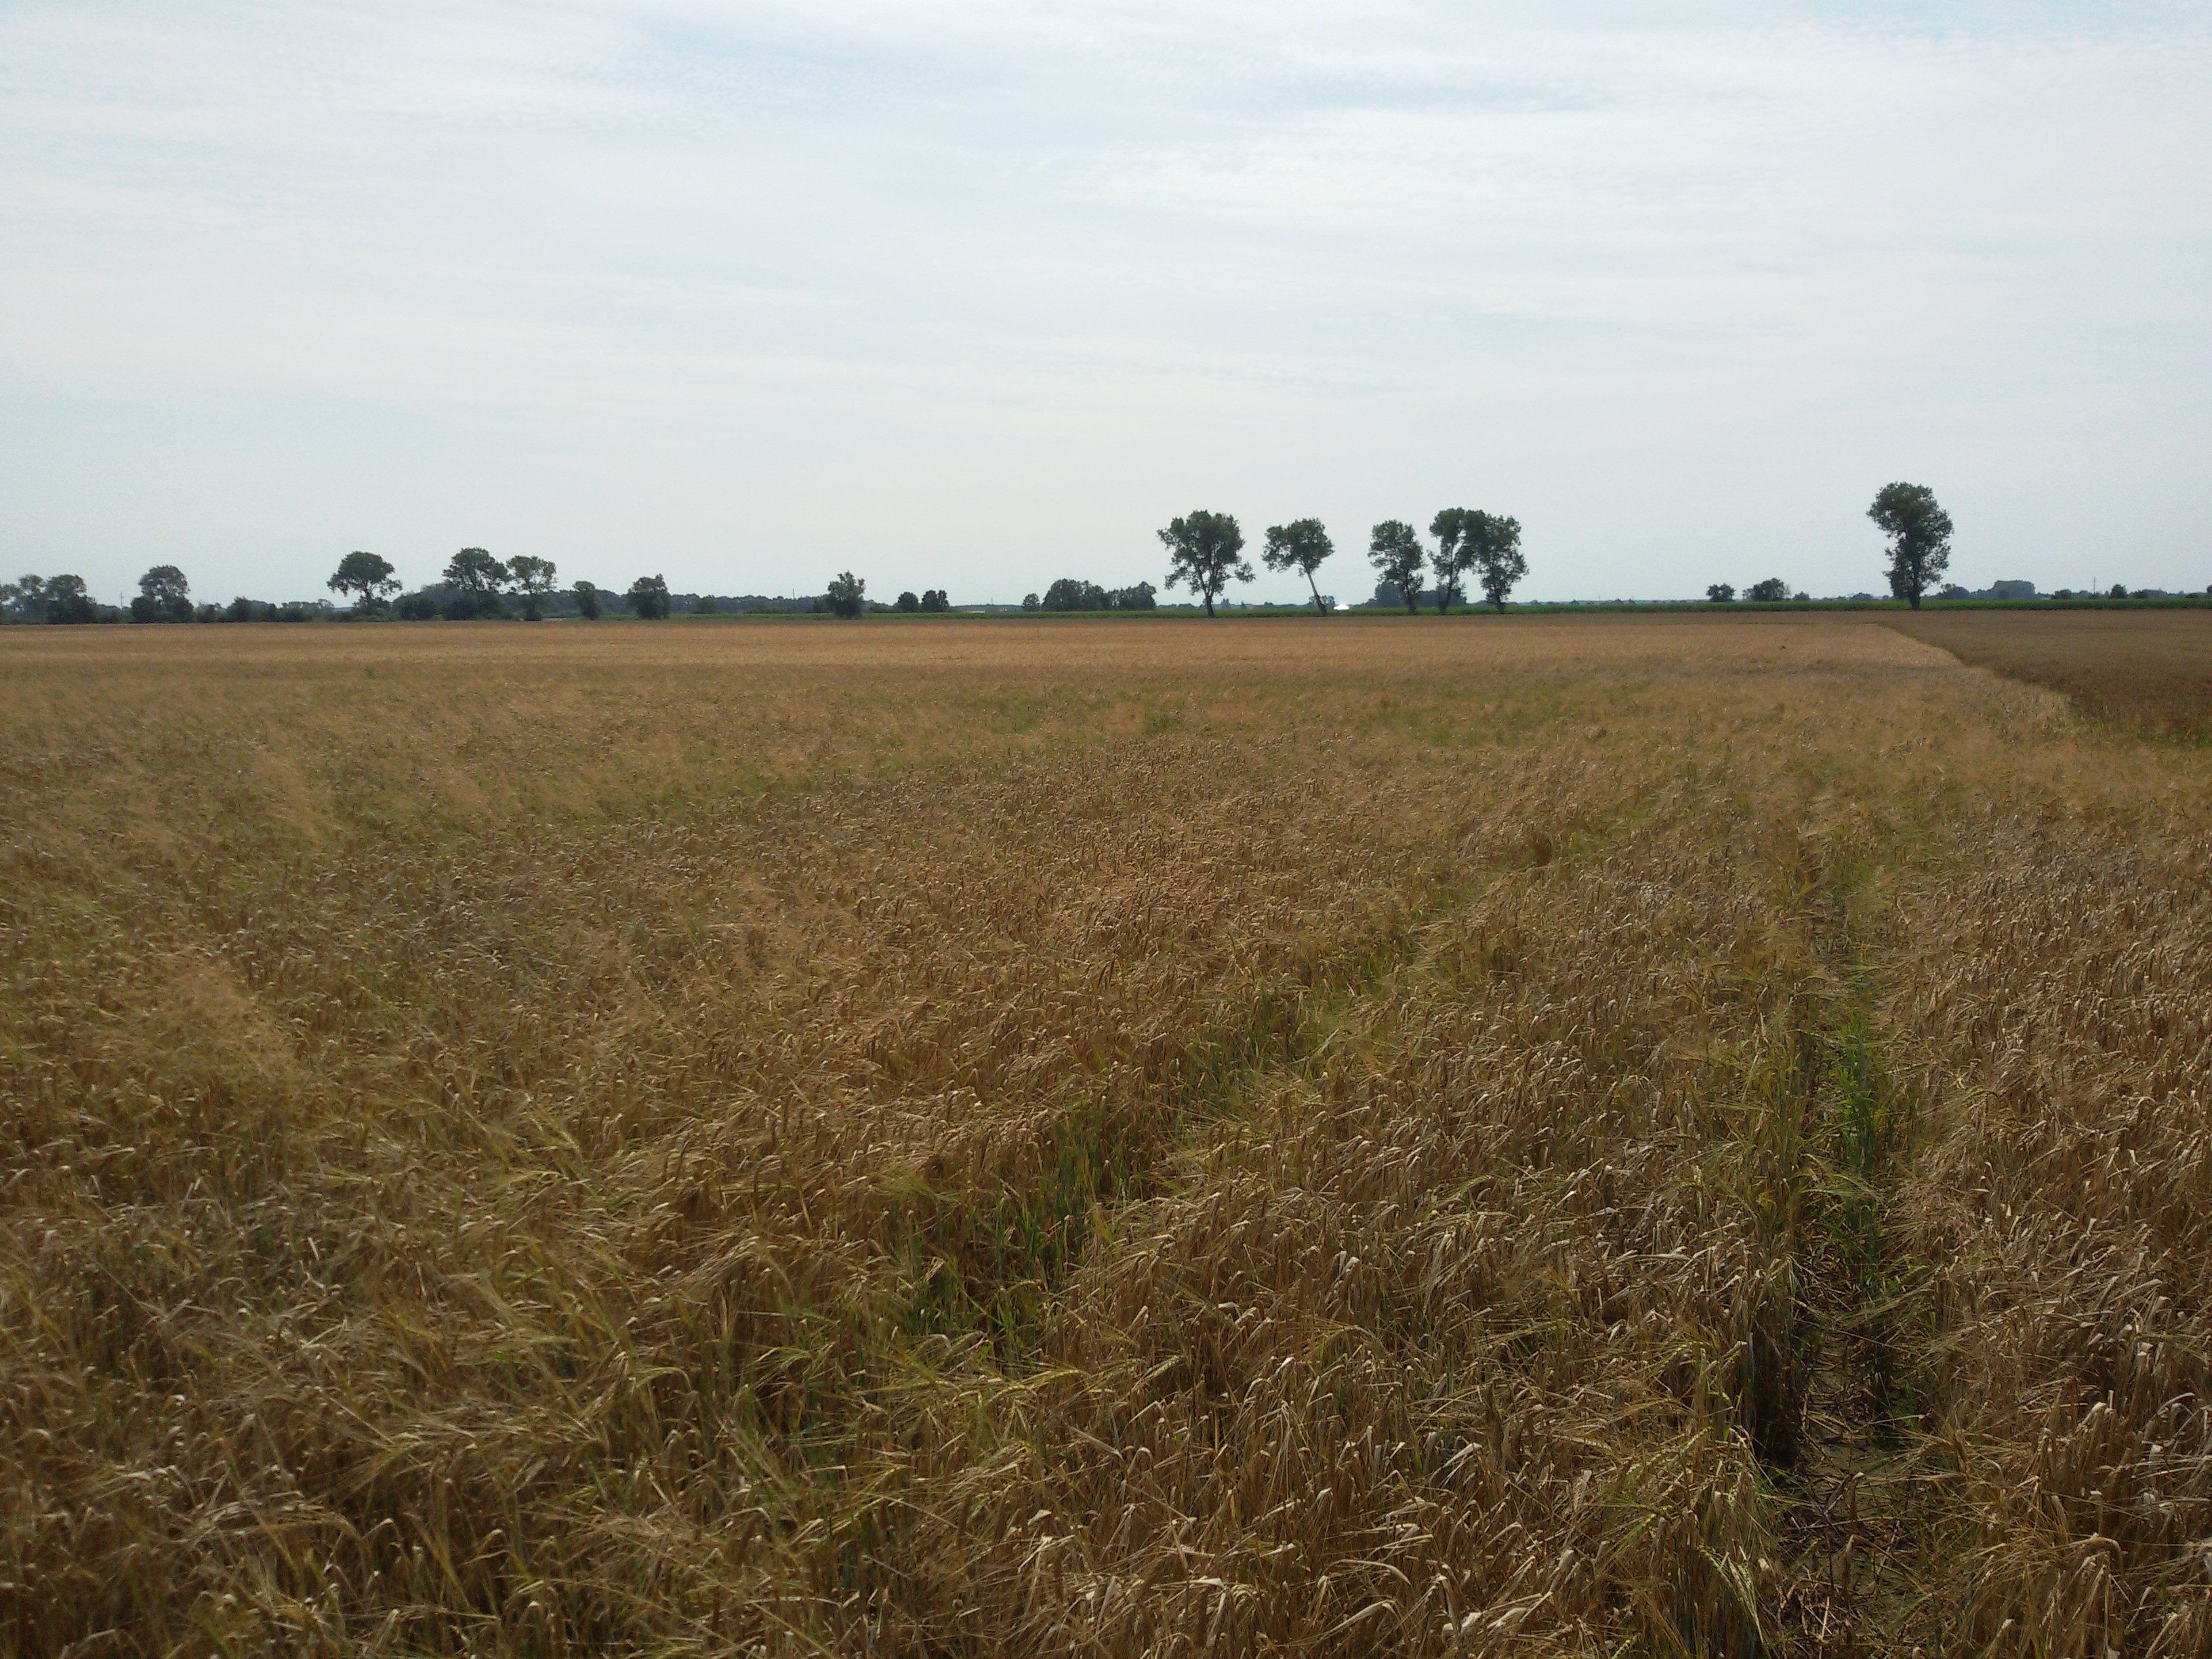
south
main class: Cropland
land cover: Barley
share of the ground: > 75 %
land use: Agriculture (excluding fallow land and kitchen gardens)
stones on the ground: < 10 %
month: July
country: PL
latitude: 52.4451
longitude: 17.5307
